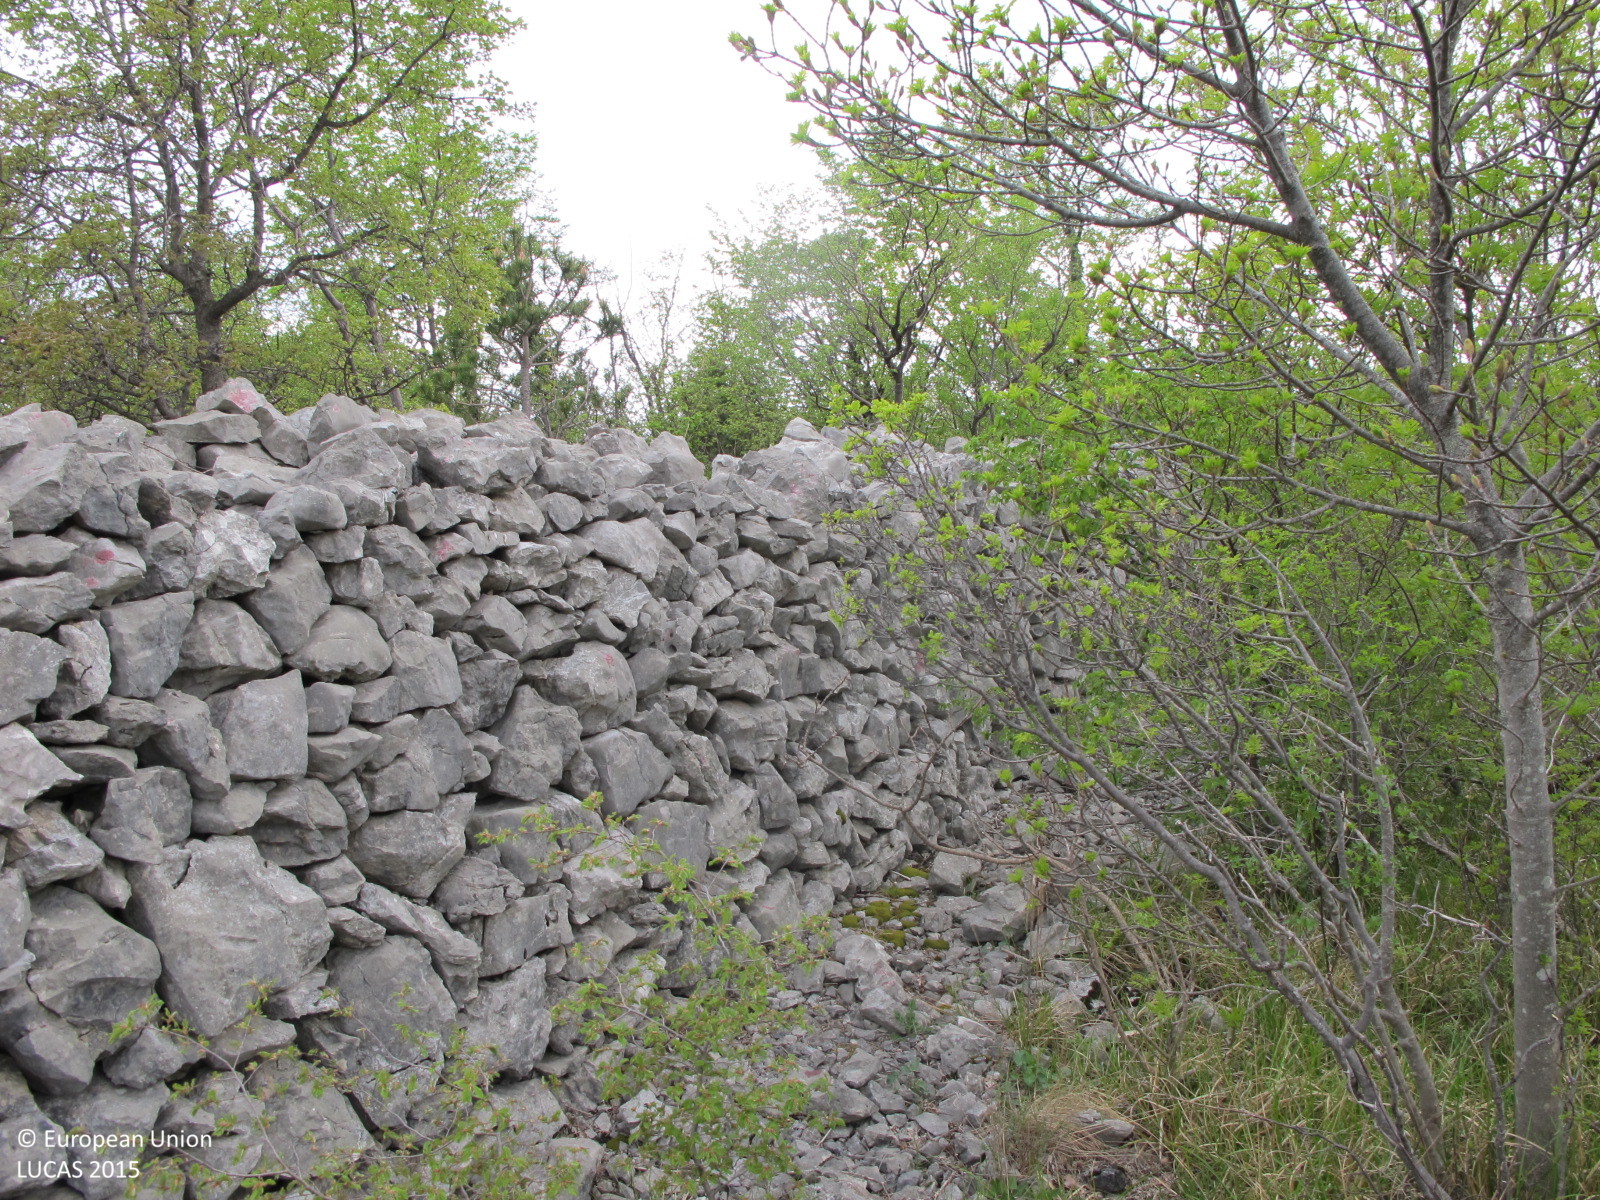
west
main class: Woodland
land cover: Broadleaved woodland
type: thermophilous deciduous forest
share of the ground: > 75 %
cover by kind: broadleaved forest trees 65 %, coniferous forest trees 10 %, shrubs 10 %, herbaceous plants 10 %
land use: Semi-natural and natural areas not in use
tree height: < 5 m
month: April
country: HR
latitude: 45.2218
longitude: 14.6431
